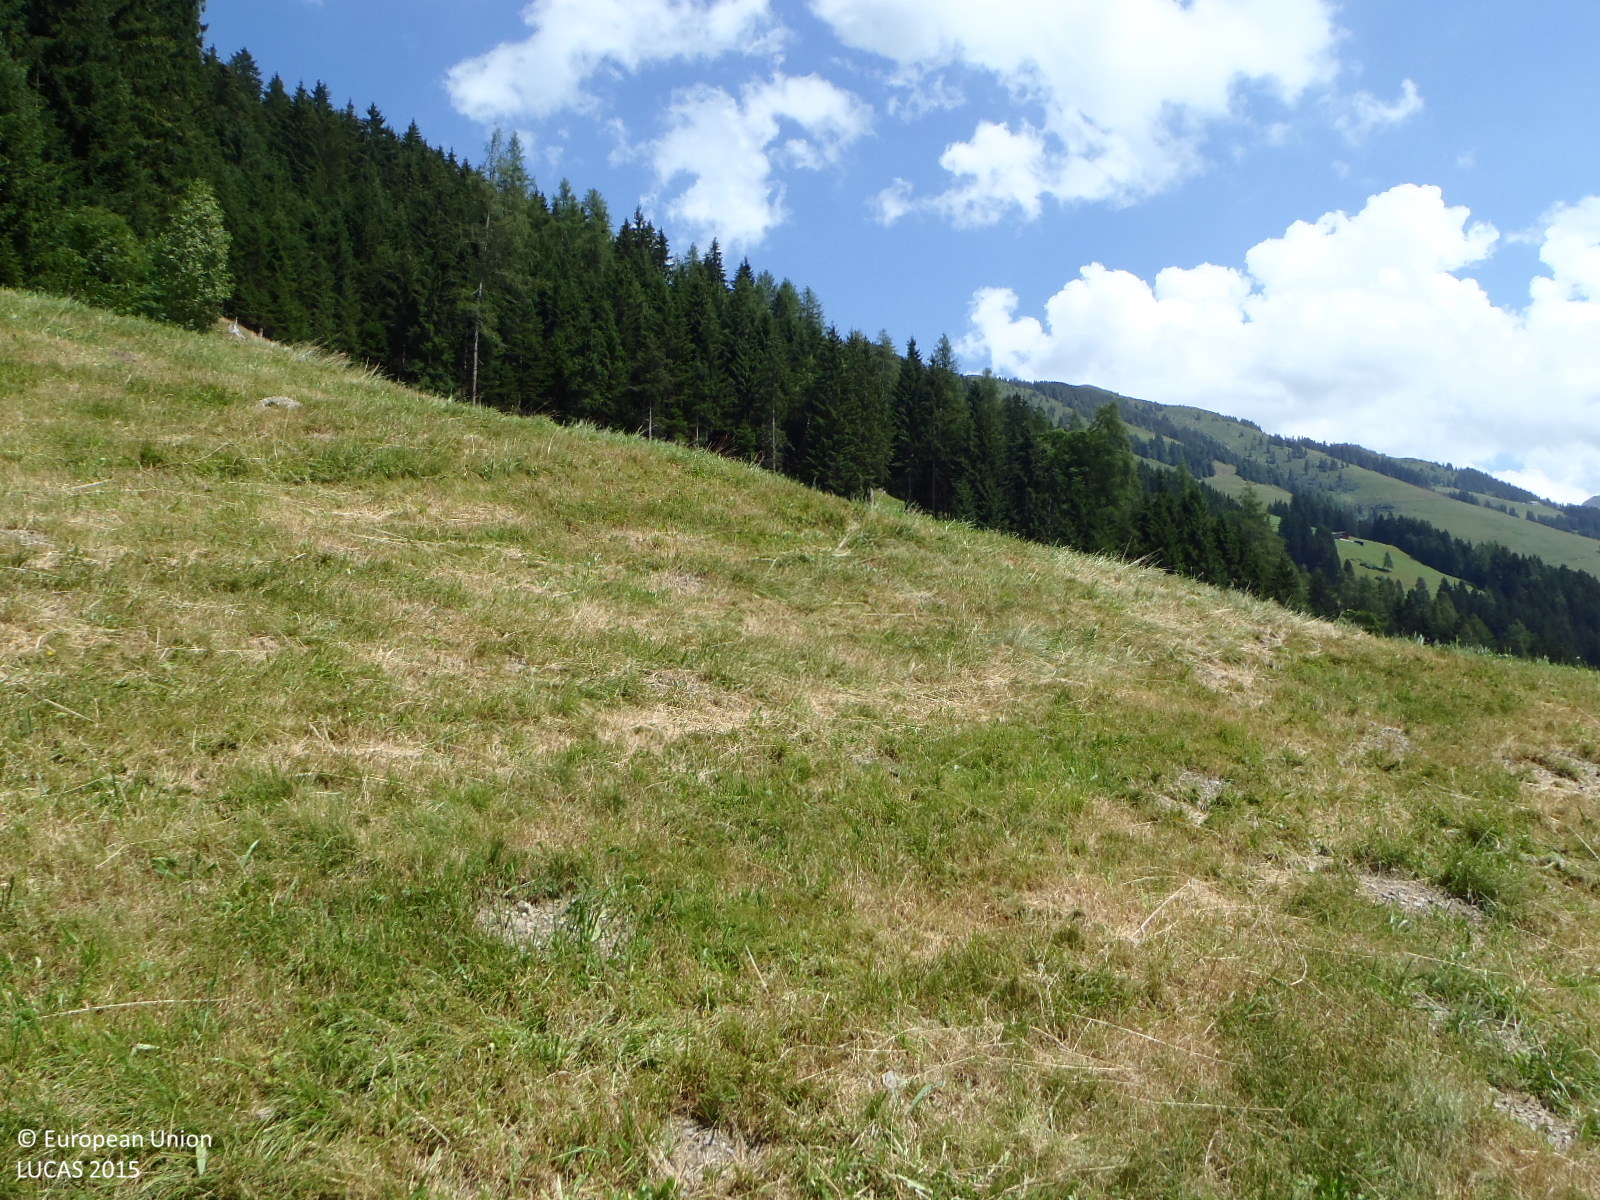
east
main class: Grassland
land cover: Grassland without tree/shrub cover
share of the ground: > 75 %
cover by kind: herbaceous plants 100 %
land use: Agriculture (excluding fallow land and kitchen gardens)
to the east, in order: Grassland without tree/shrub cover; Fences; Grassland without tree/shrub cover; Spruce dominated coniferous woodland; Fences; Spruce dominated coniferous woodland; Fences; Tracks; Grassland without tree/shrub cover; Spruce dominated coniferous woodland; Ditches and canals; Spruce dominated coniferous woodland; Fences; Spruce dominated coniferous woodland
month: July
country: AT
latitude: 47.3777
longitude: 11.9719
